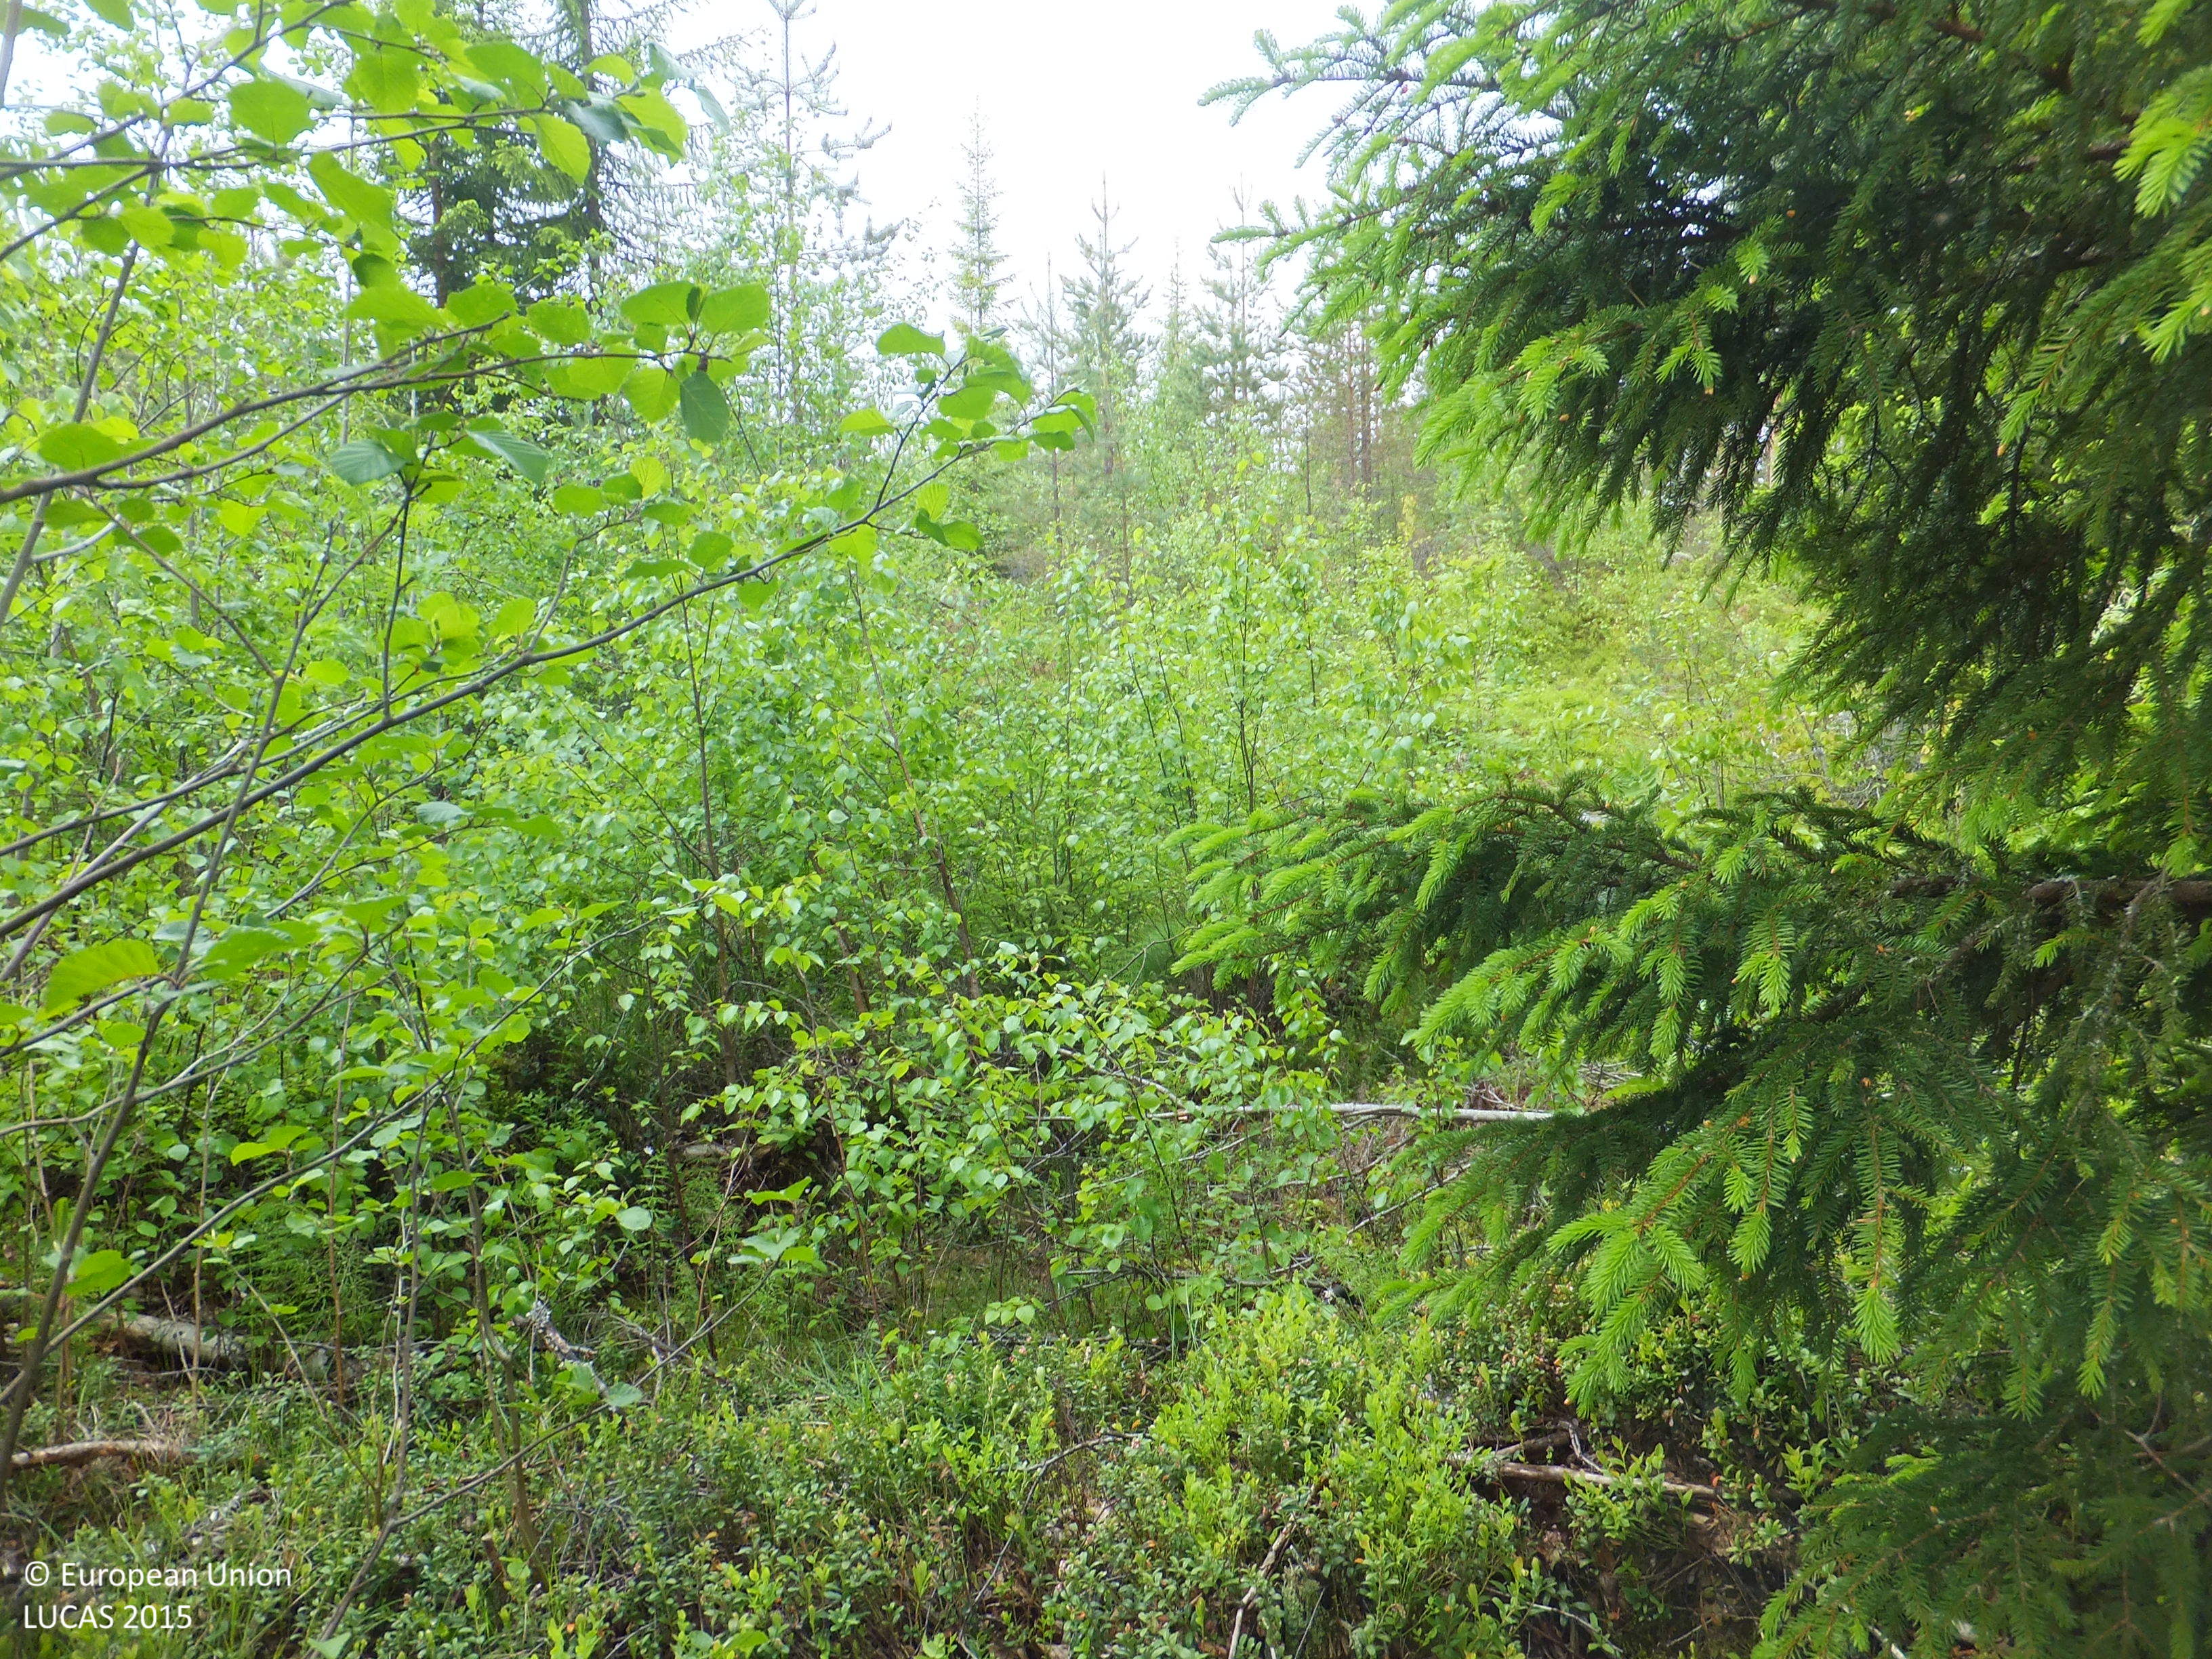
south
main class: Woodland
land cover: Other mixed woodland
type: boreal forest
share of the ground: 50 - 75 %
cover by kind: coniferous forest trees 35 %, broadleaved forest trees 35 %, shrubs 20 %, herbaceous plants 5 %, lichens and mosses 5 %
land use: Forestry
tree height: > 5 m
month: June
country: FI
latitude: 63.6433
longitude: 24.8023
